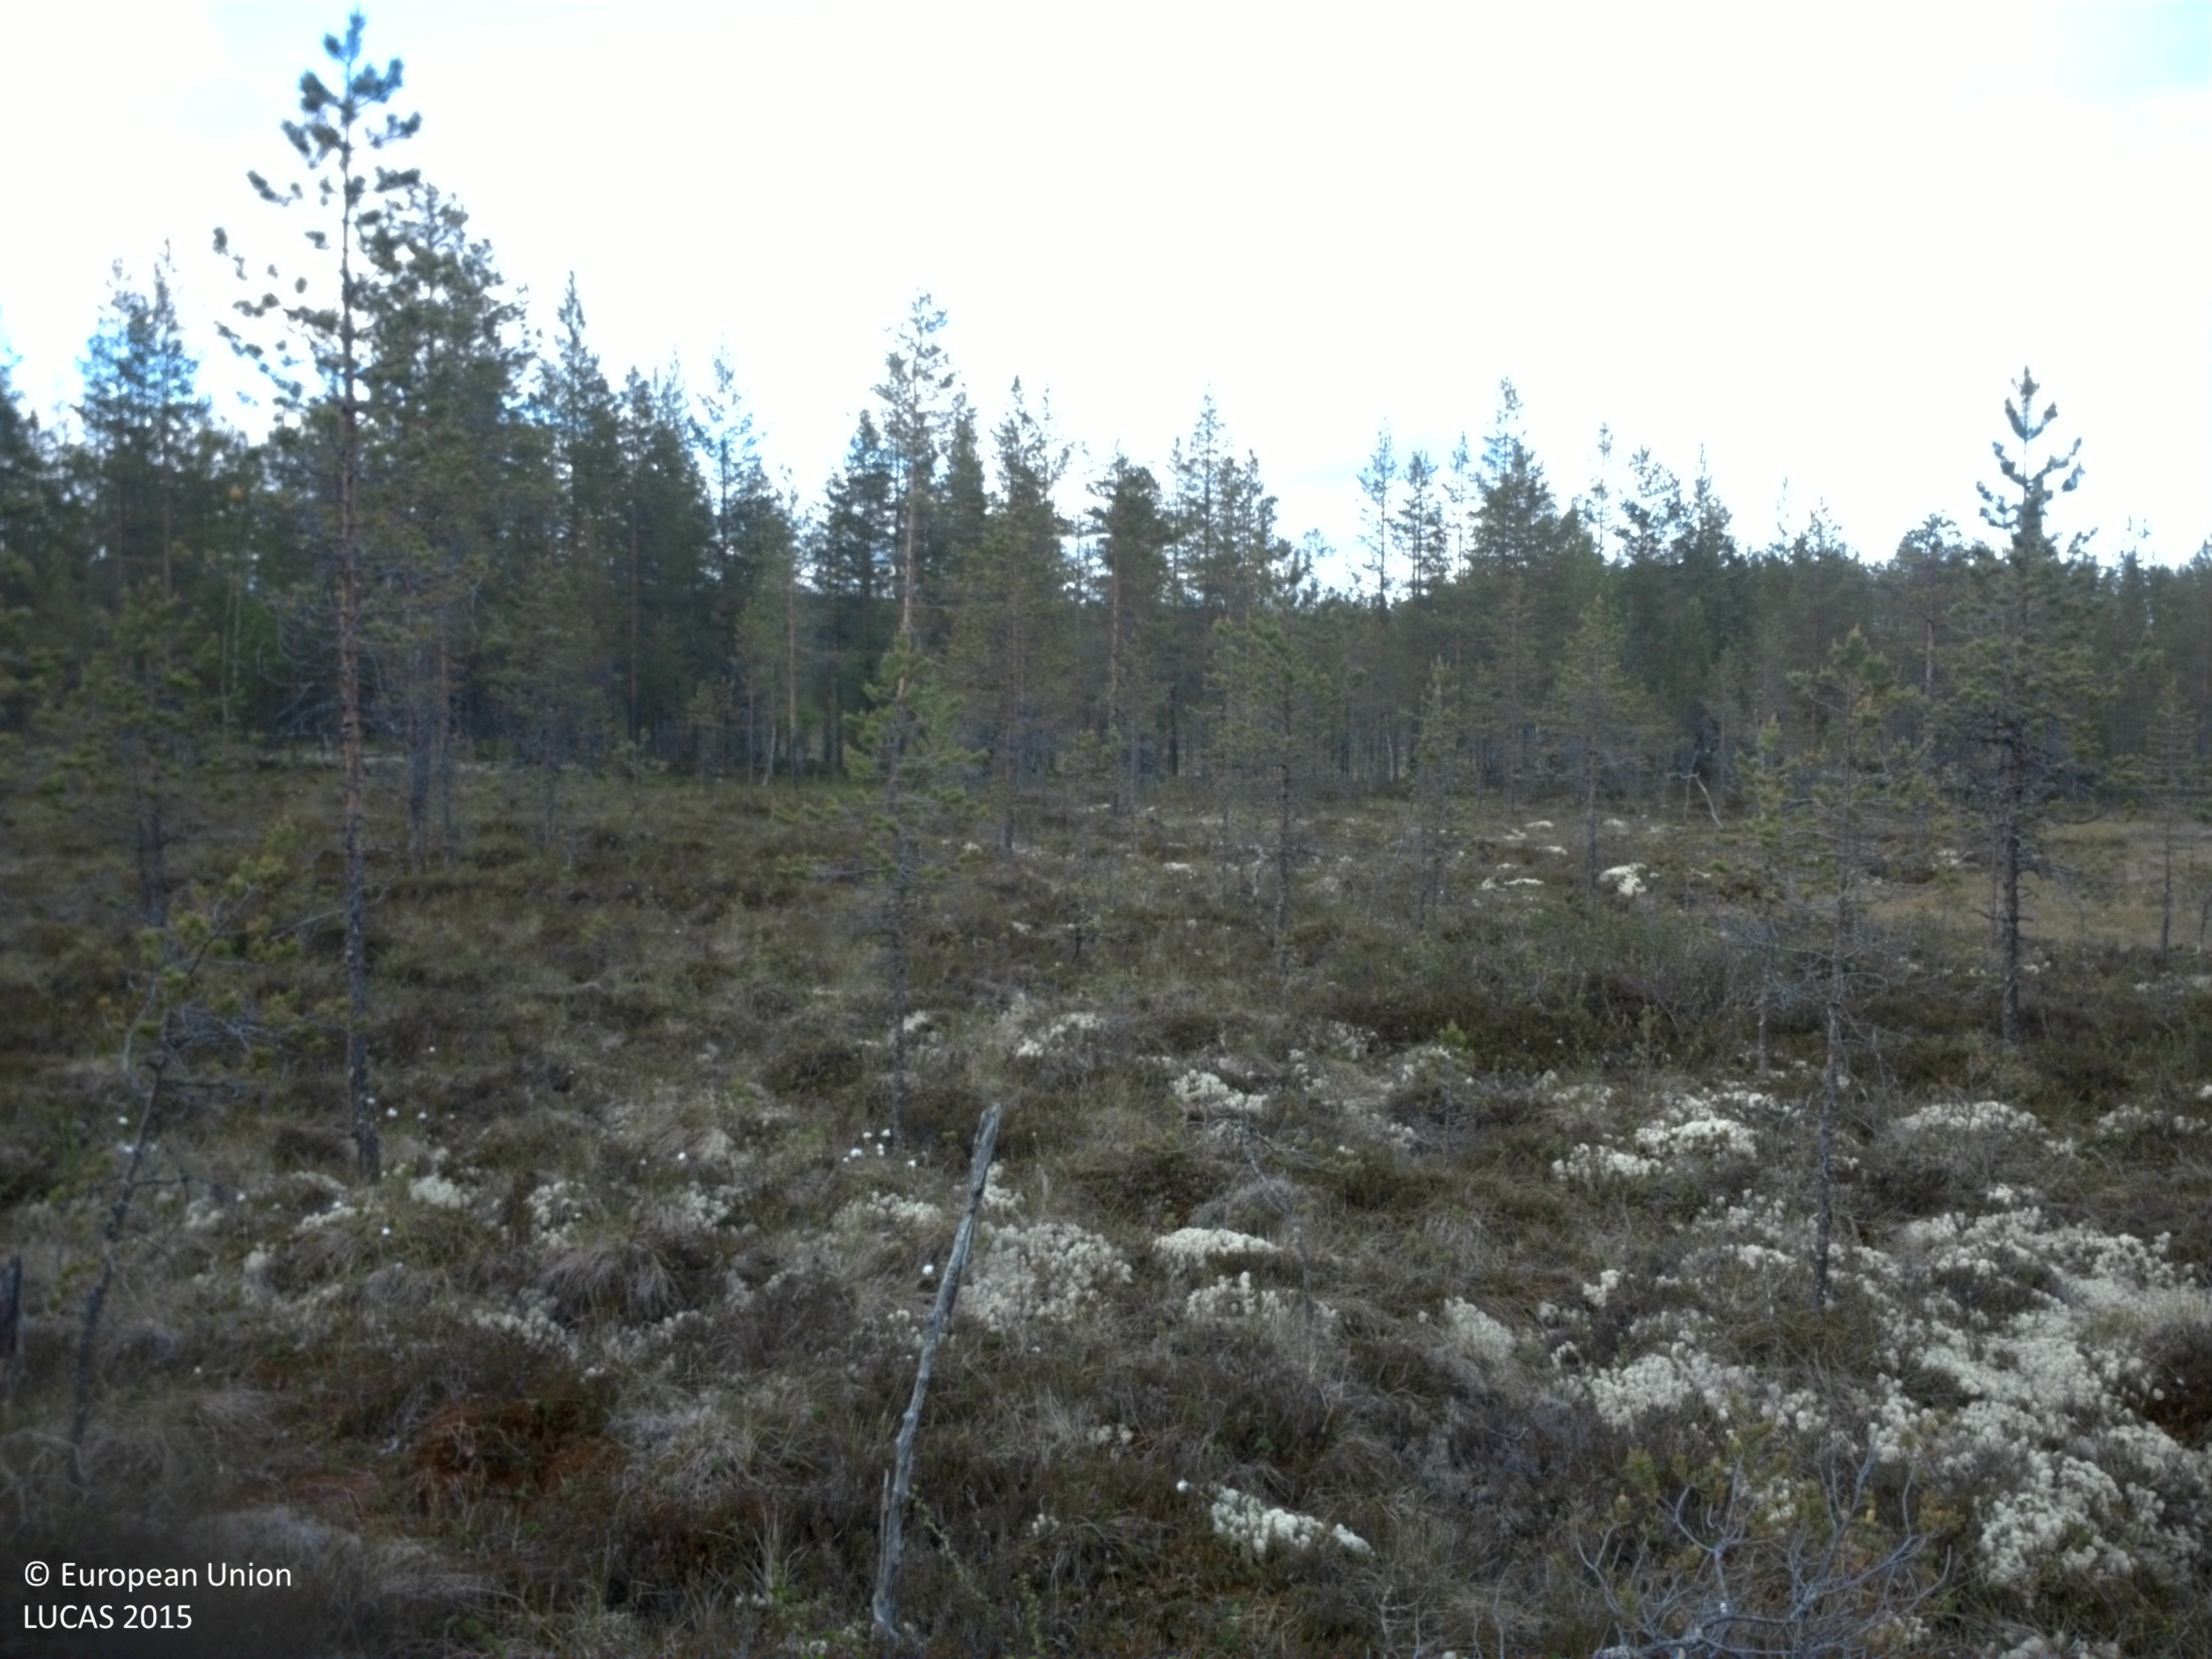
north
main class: Woodland
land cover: Pine dominated coniferous woodland
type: boreal forest
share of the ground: 25 - 50 %
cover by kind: lichens and mosses 50 %, coniferous forest trees 35 %, herbaceous plants 15 %
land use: Semi-natural and natural areas not in use
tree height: < 5 m
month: June
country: SE
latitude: 61.2509
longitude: 13.6592
